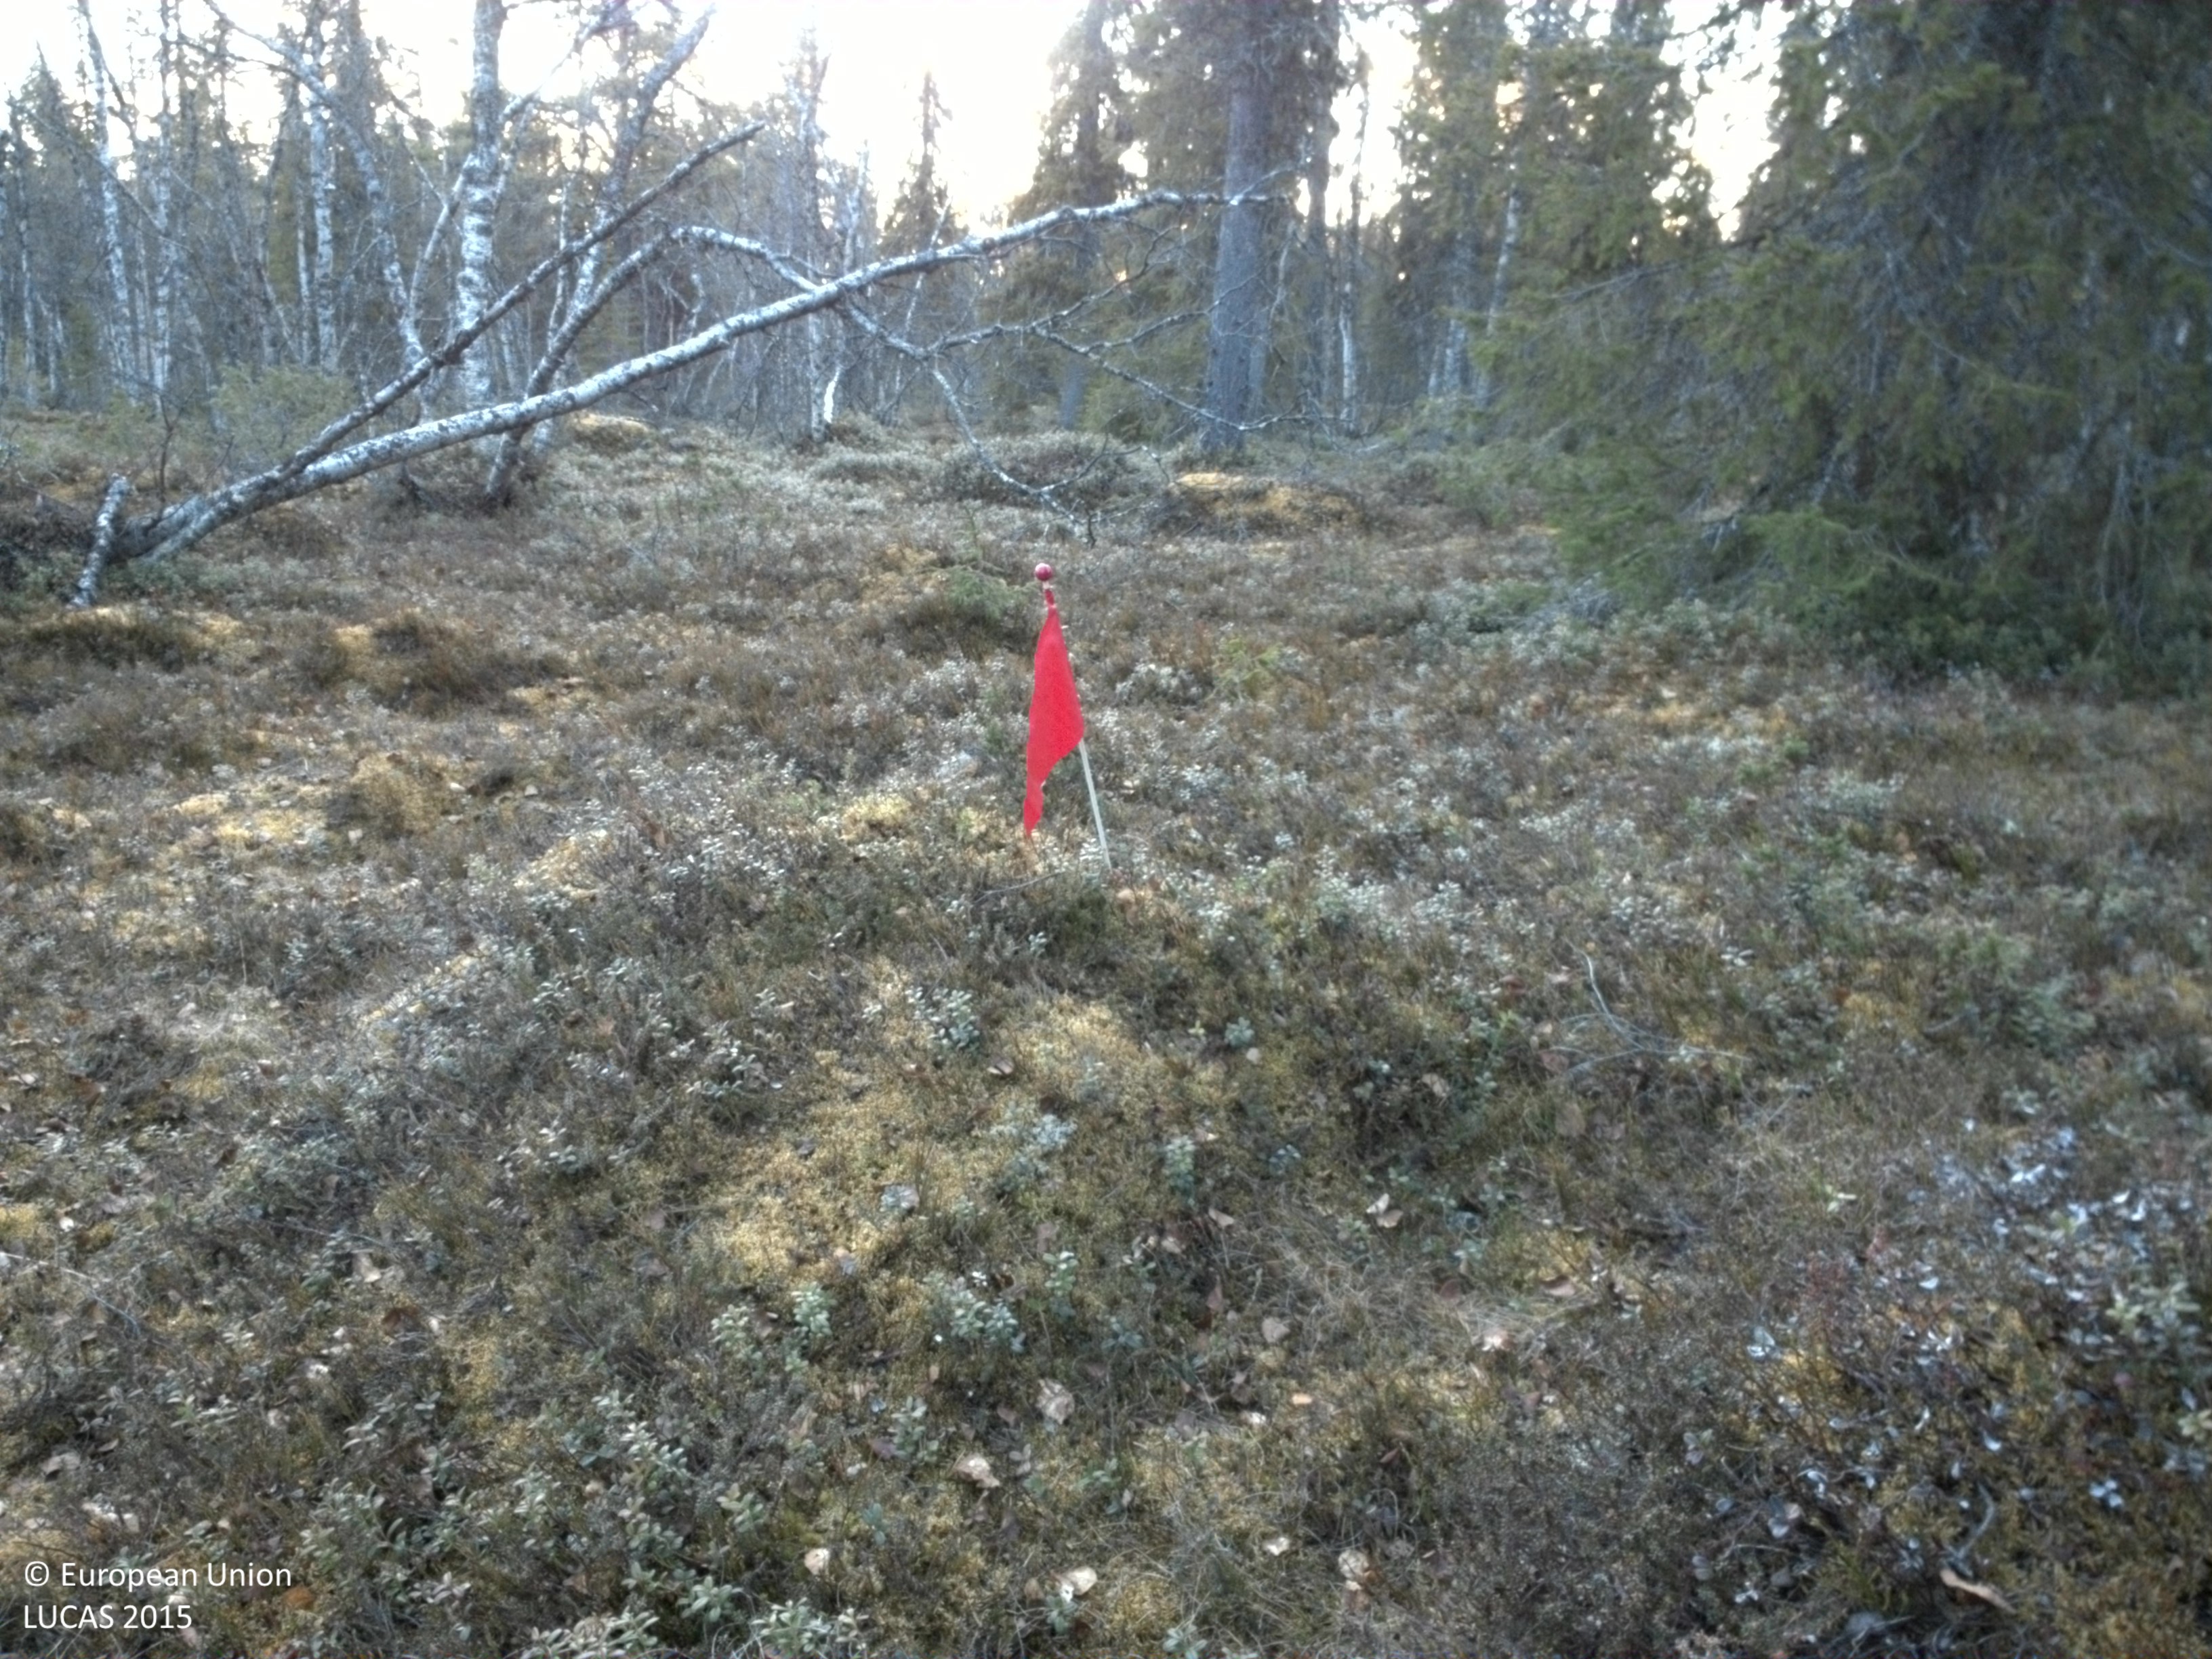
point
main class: Woodland
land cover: Spruce dominated mixed woodland
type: boreal forest
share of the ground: 25 - 50 %
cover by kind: herbaceous plants 55 %, coniferous forest trees 15 %, lichens and mosses 15 %, broadleaved forest trees 10 %, shrubs 5 %
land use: Forestry
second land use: Amenities, museums, leisure
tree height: > 5 m
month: June
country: SE
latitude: 67.3055
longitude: 20.1417
